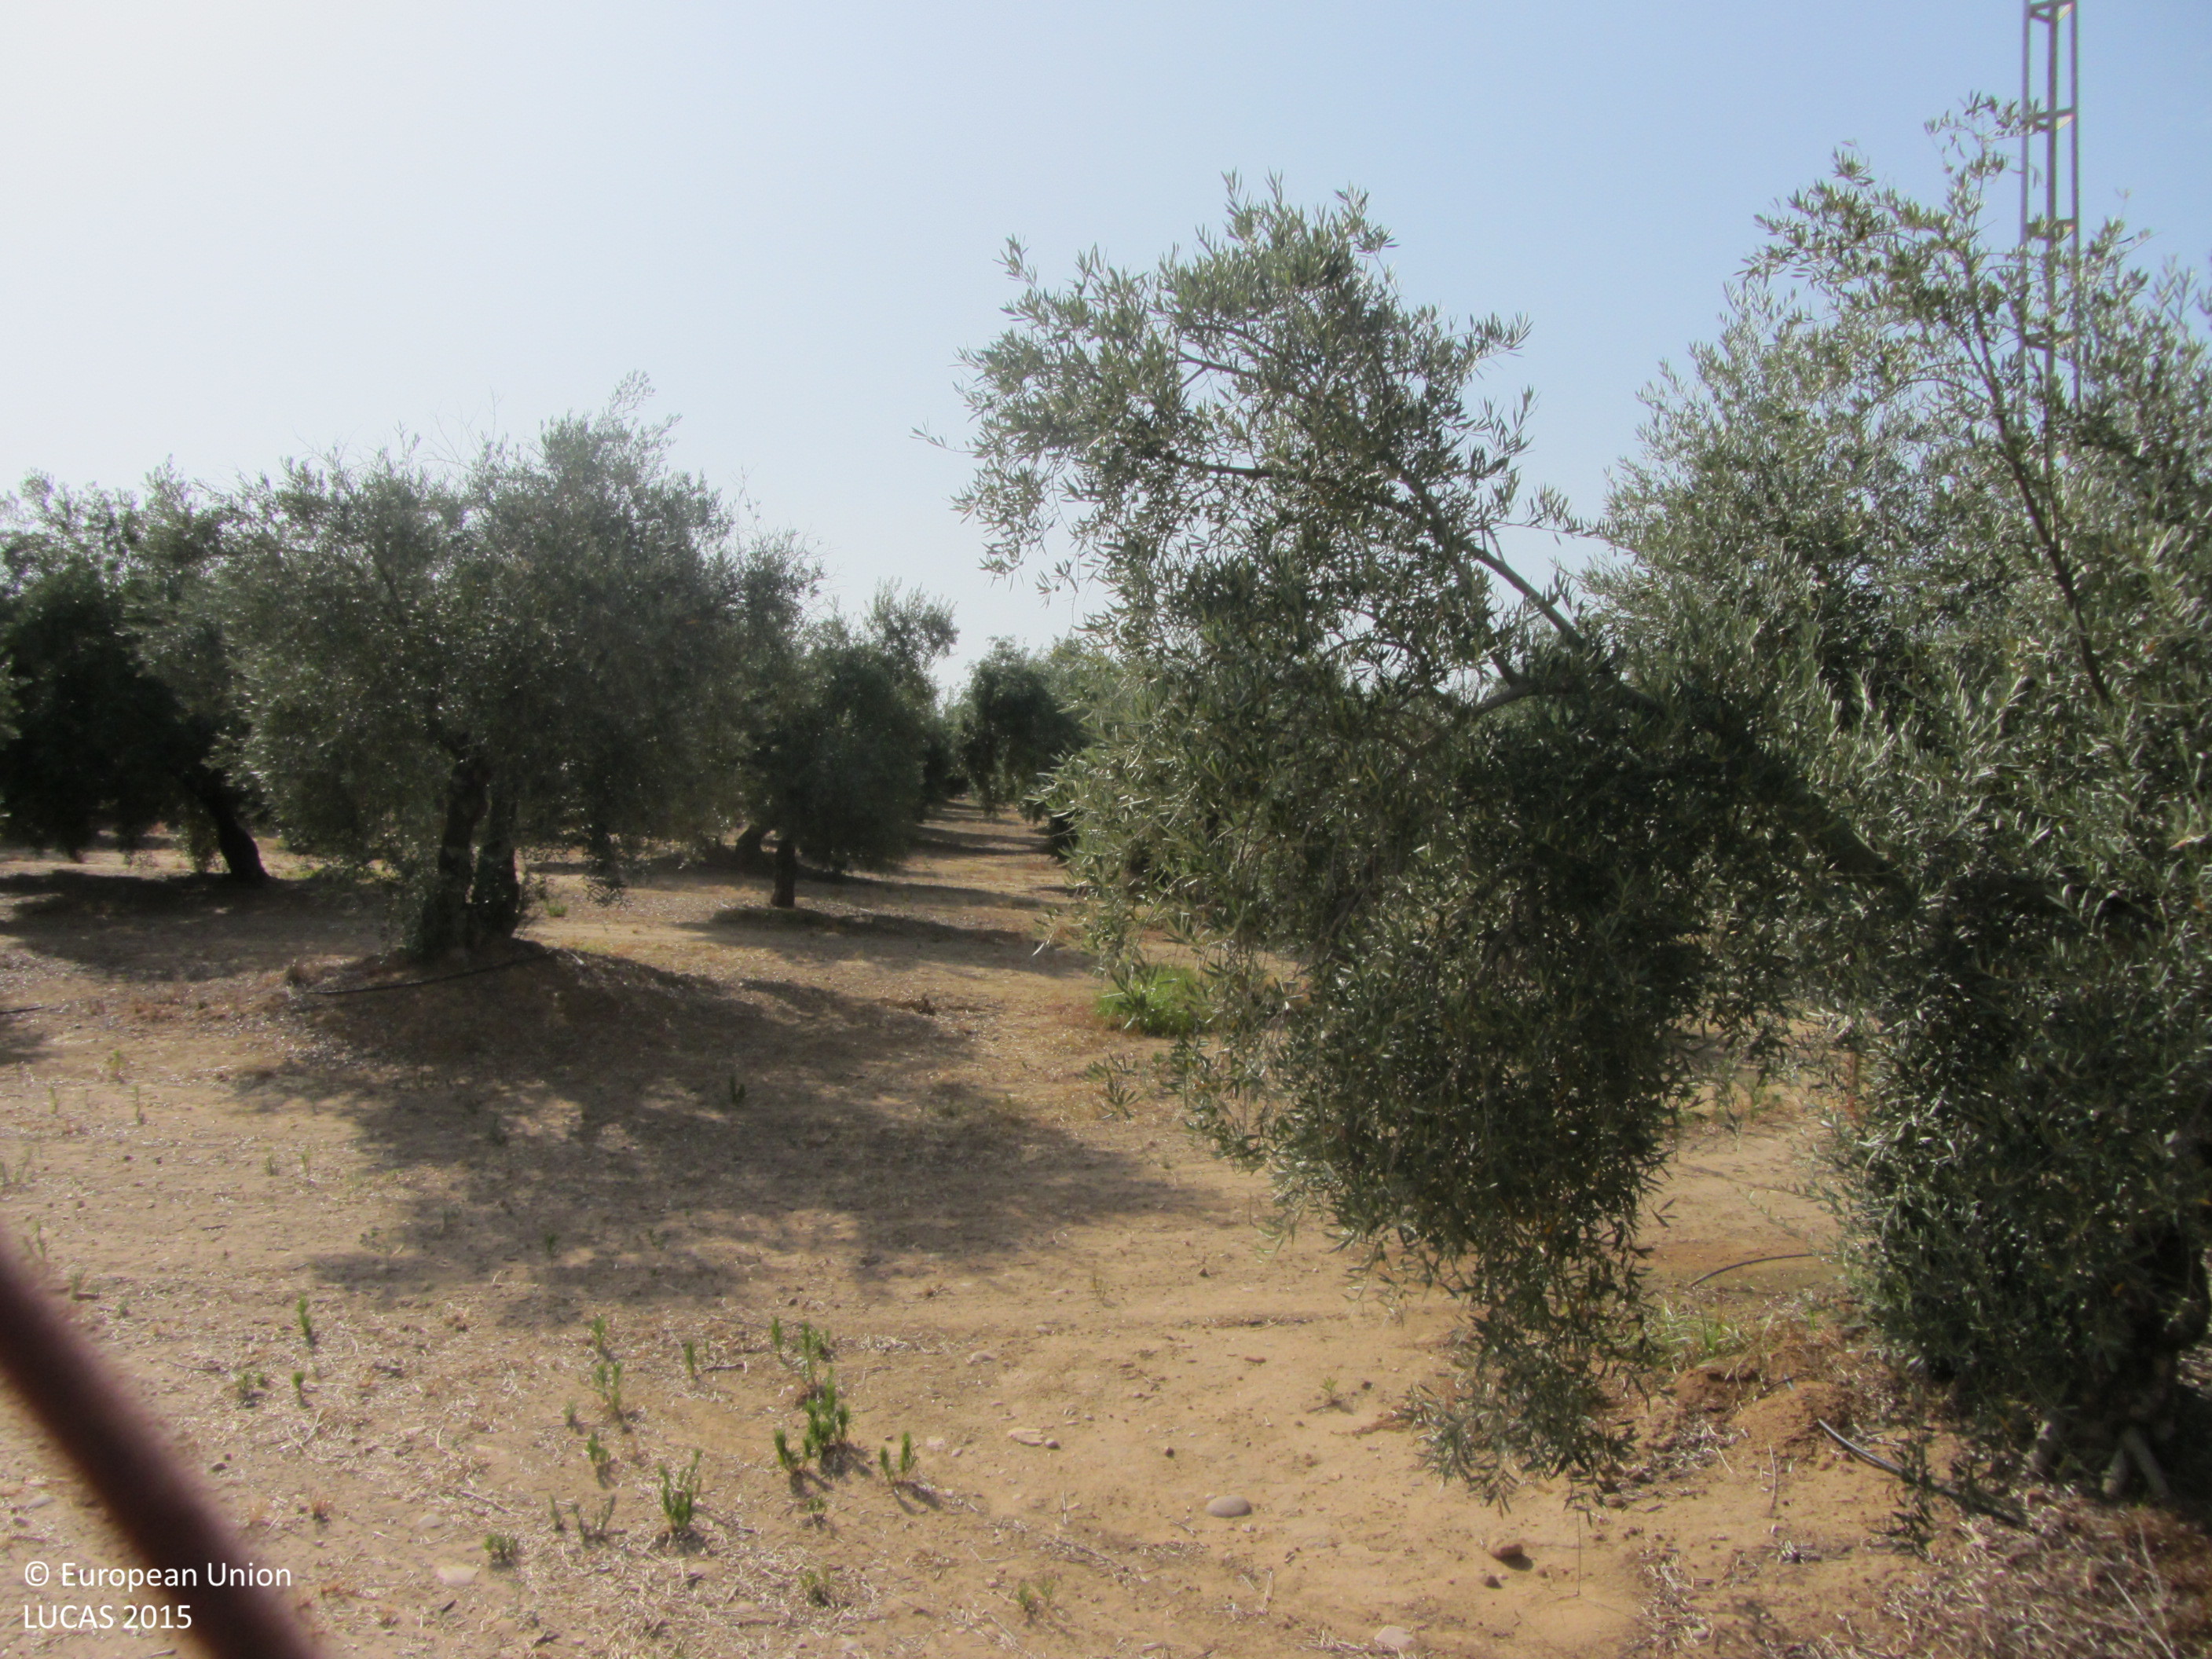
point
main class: Cropland
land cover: Olive groves
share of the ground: 50 - 75 %
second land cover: Other bare soil
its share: > 75 %
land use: Agriculture (excluding fallow land and kitchen gardens)
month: July
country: ES
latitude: 38.1008
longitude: -3.8850
